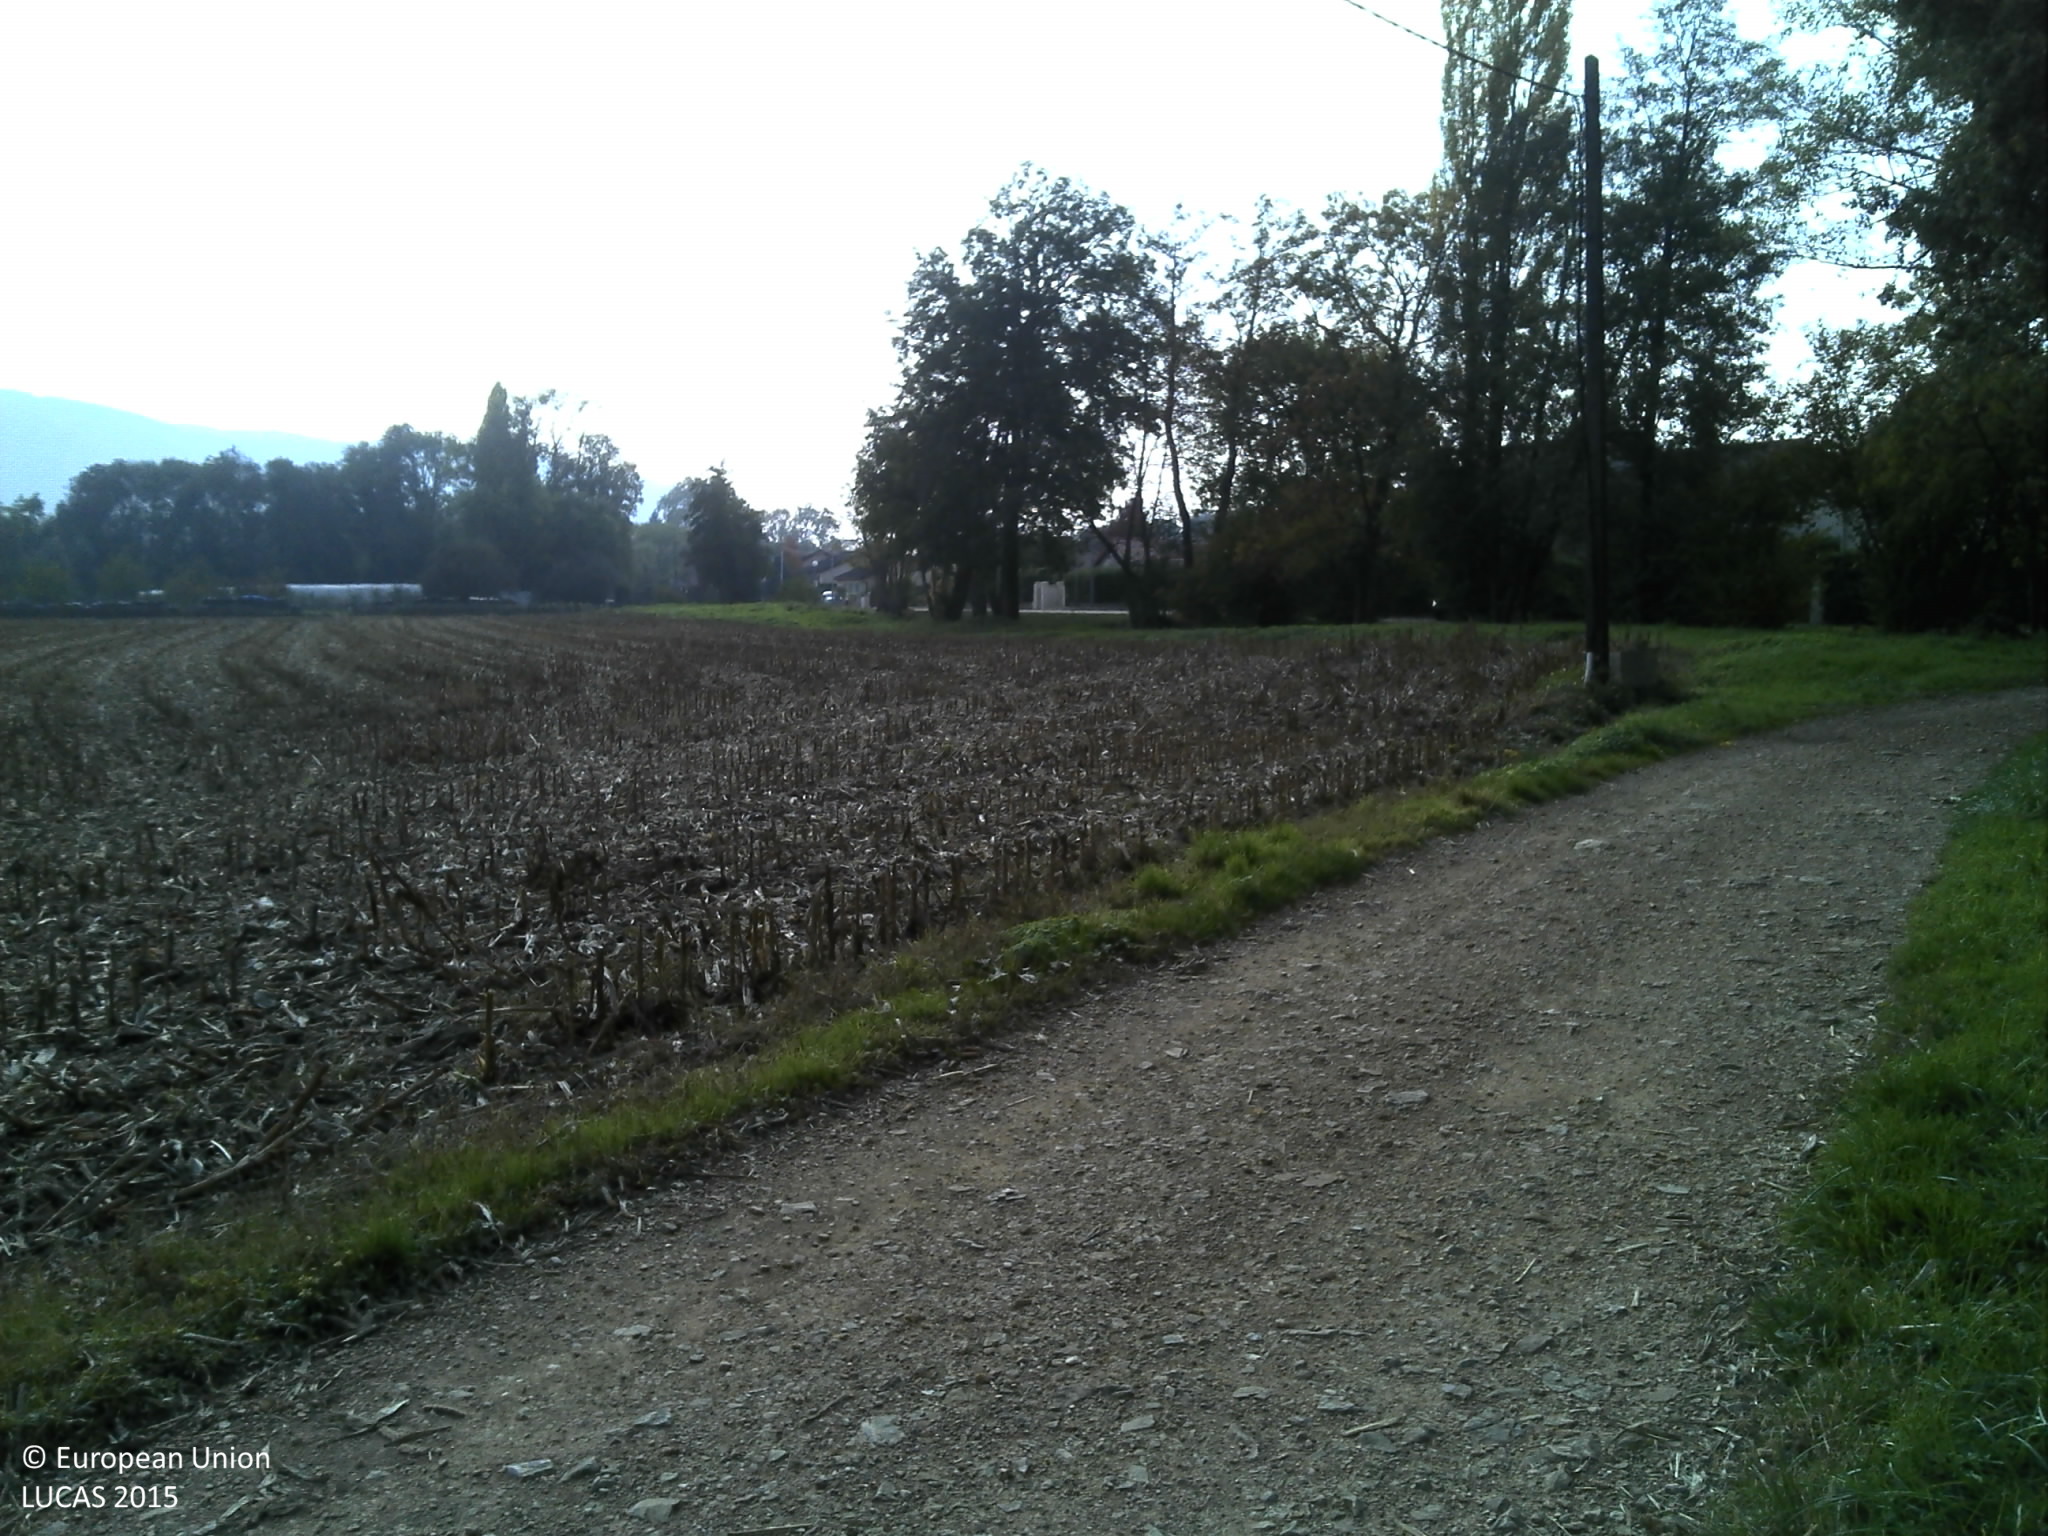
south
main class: Cropland
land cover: Maize
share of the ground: < 10 %
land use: Agriculture (excluding fallow land and kitchen gardens)
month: October
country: FR
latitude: 45.8893
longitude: 5.3516
